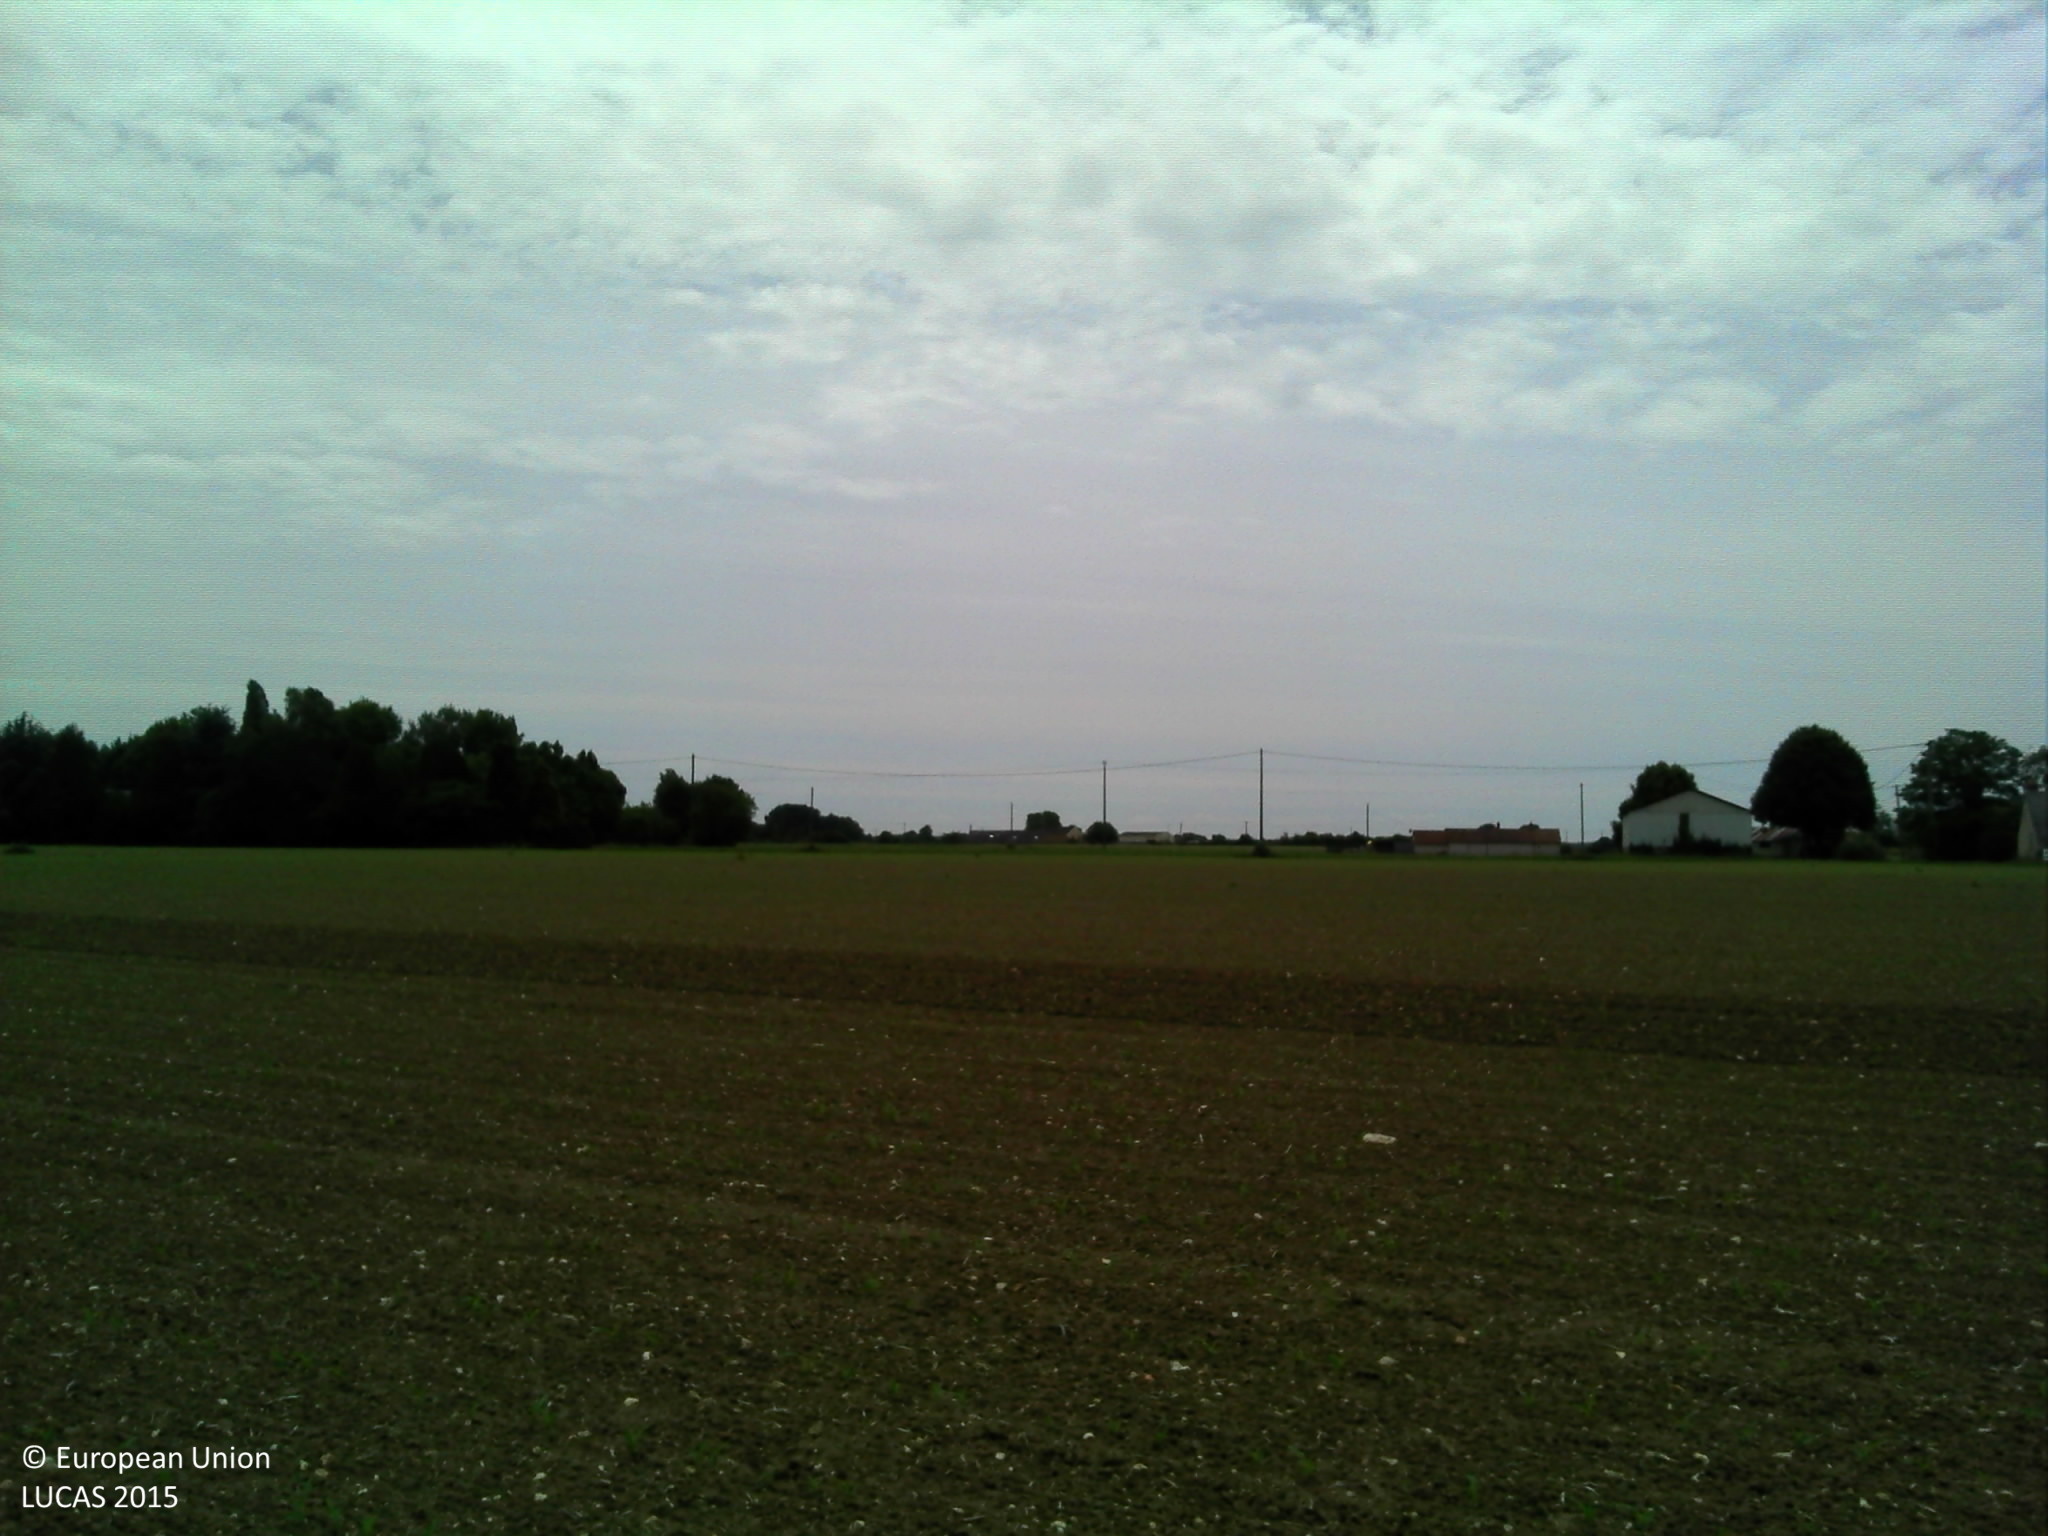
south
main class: Cropland
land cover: Maize
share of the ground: < 10 %
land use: Agriculture (excluding fallow land and kitchen gardens)
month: June
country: FR
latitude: 47.6104
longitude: 0.0634
